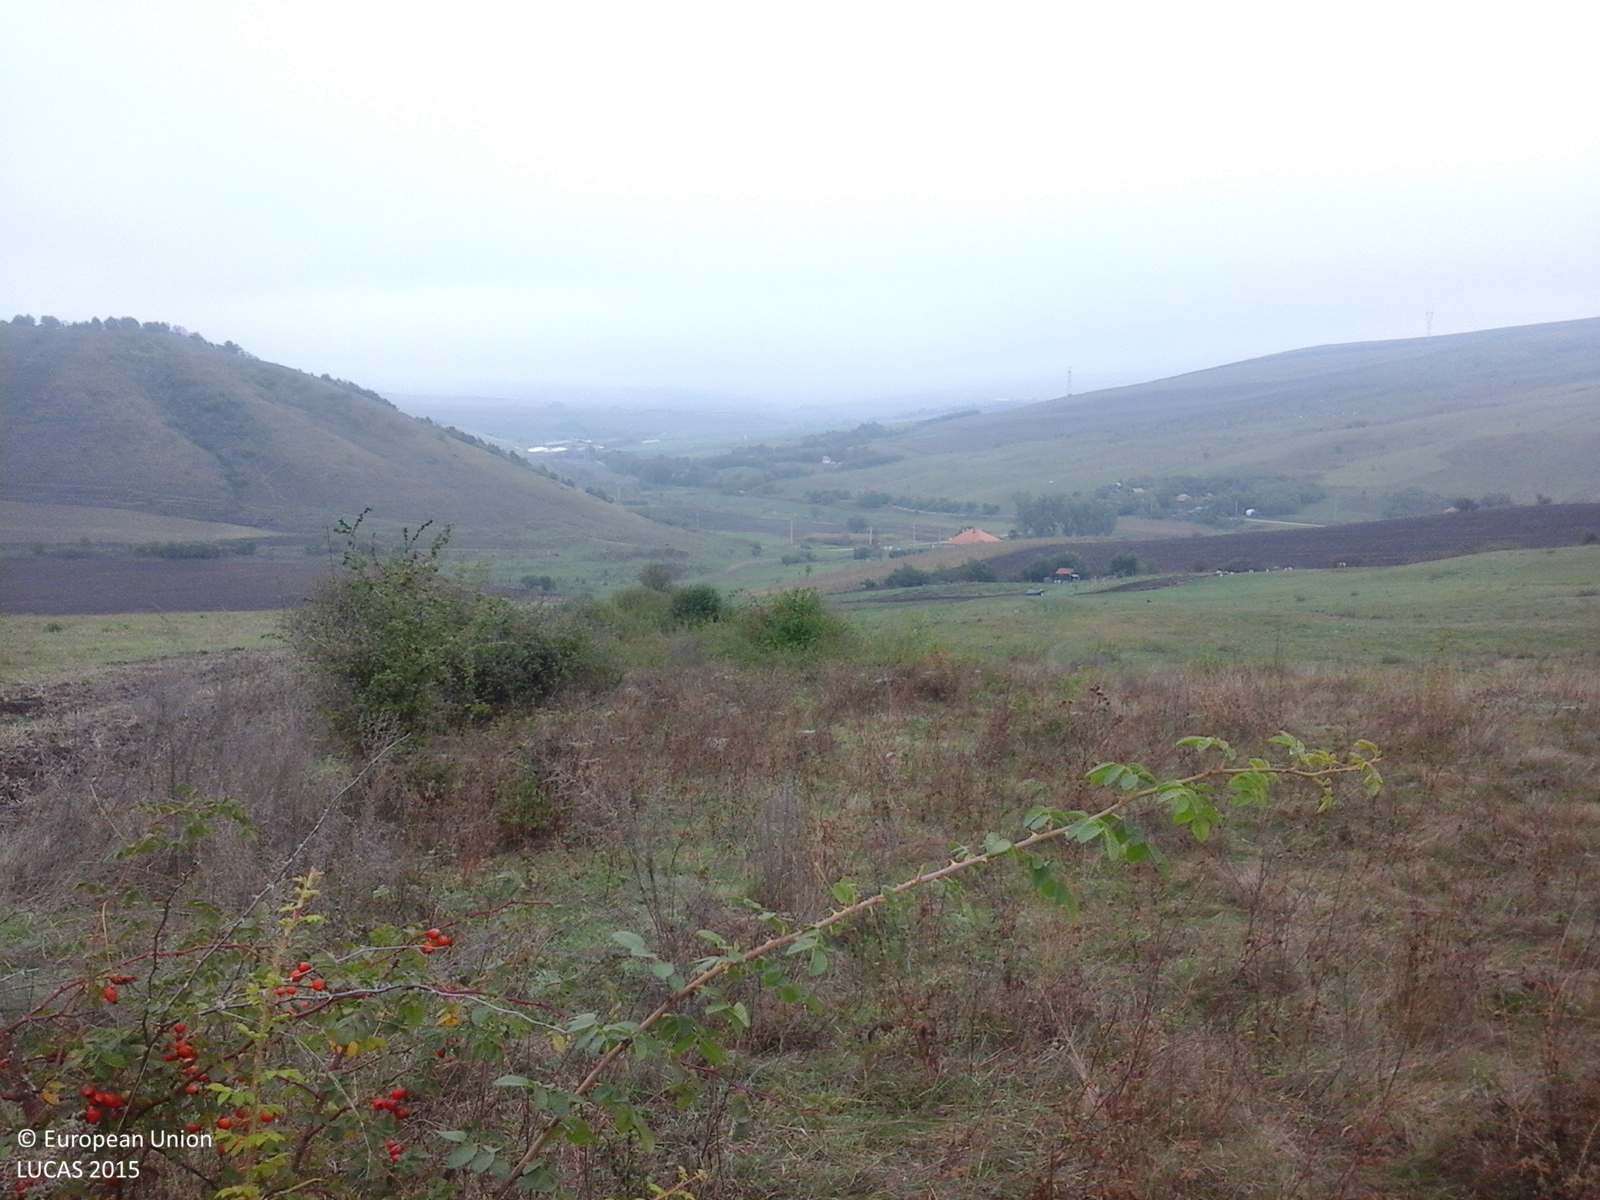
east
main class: Grassland
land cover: Grassland with sparse tree/shrub cover
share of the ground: > 75 %
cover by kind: herbaceous plants 95 %, broadleaved forest trees 5 %
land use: Agriculture (excluding fallow land and kitchen gardens)
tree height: < 5 m
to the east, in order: Grassland with sparse tree/shrub cover; Tracks; Grassland with sparse tree/shrub cover
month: October
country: RO
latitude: 46.5941
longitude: 24.1380
